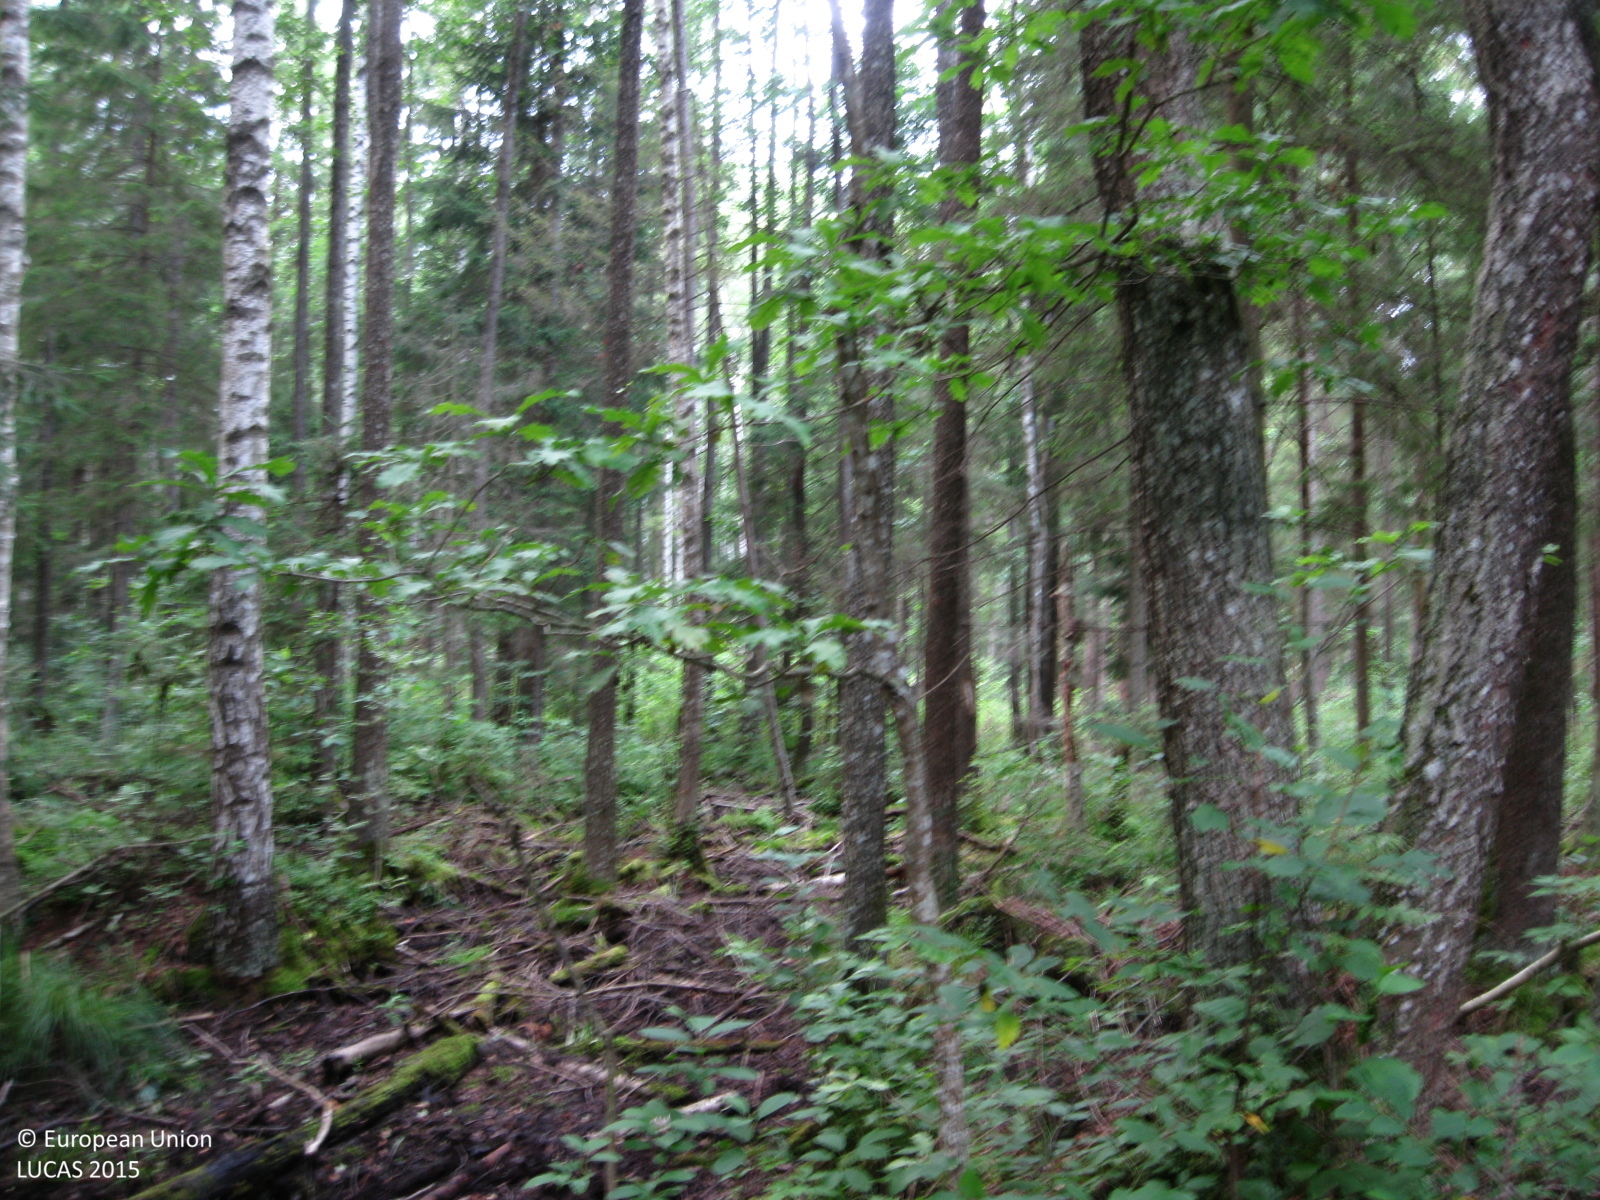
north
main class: Woodland
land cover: Spruce dominated mixed woodland
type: hemiboreal forest and nemoral coniferous forest and mixed broadleaved-coniferous forest
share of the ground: > 75 %
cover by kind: coniferous forest trees 45 %, broadleaved forest trees 35 %, herbaceous plants 10 %, shrubs 5 %, unconsolidated bare surface 5 %
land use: Forestry
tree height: > 5 m
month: July
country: LT
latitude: 55.3995
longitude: 24.6145
